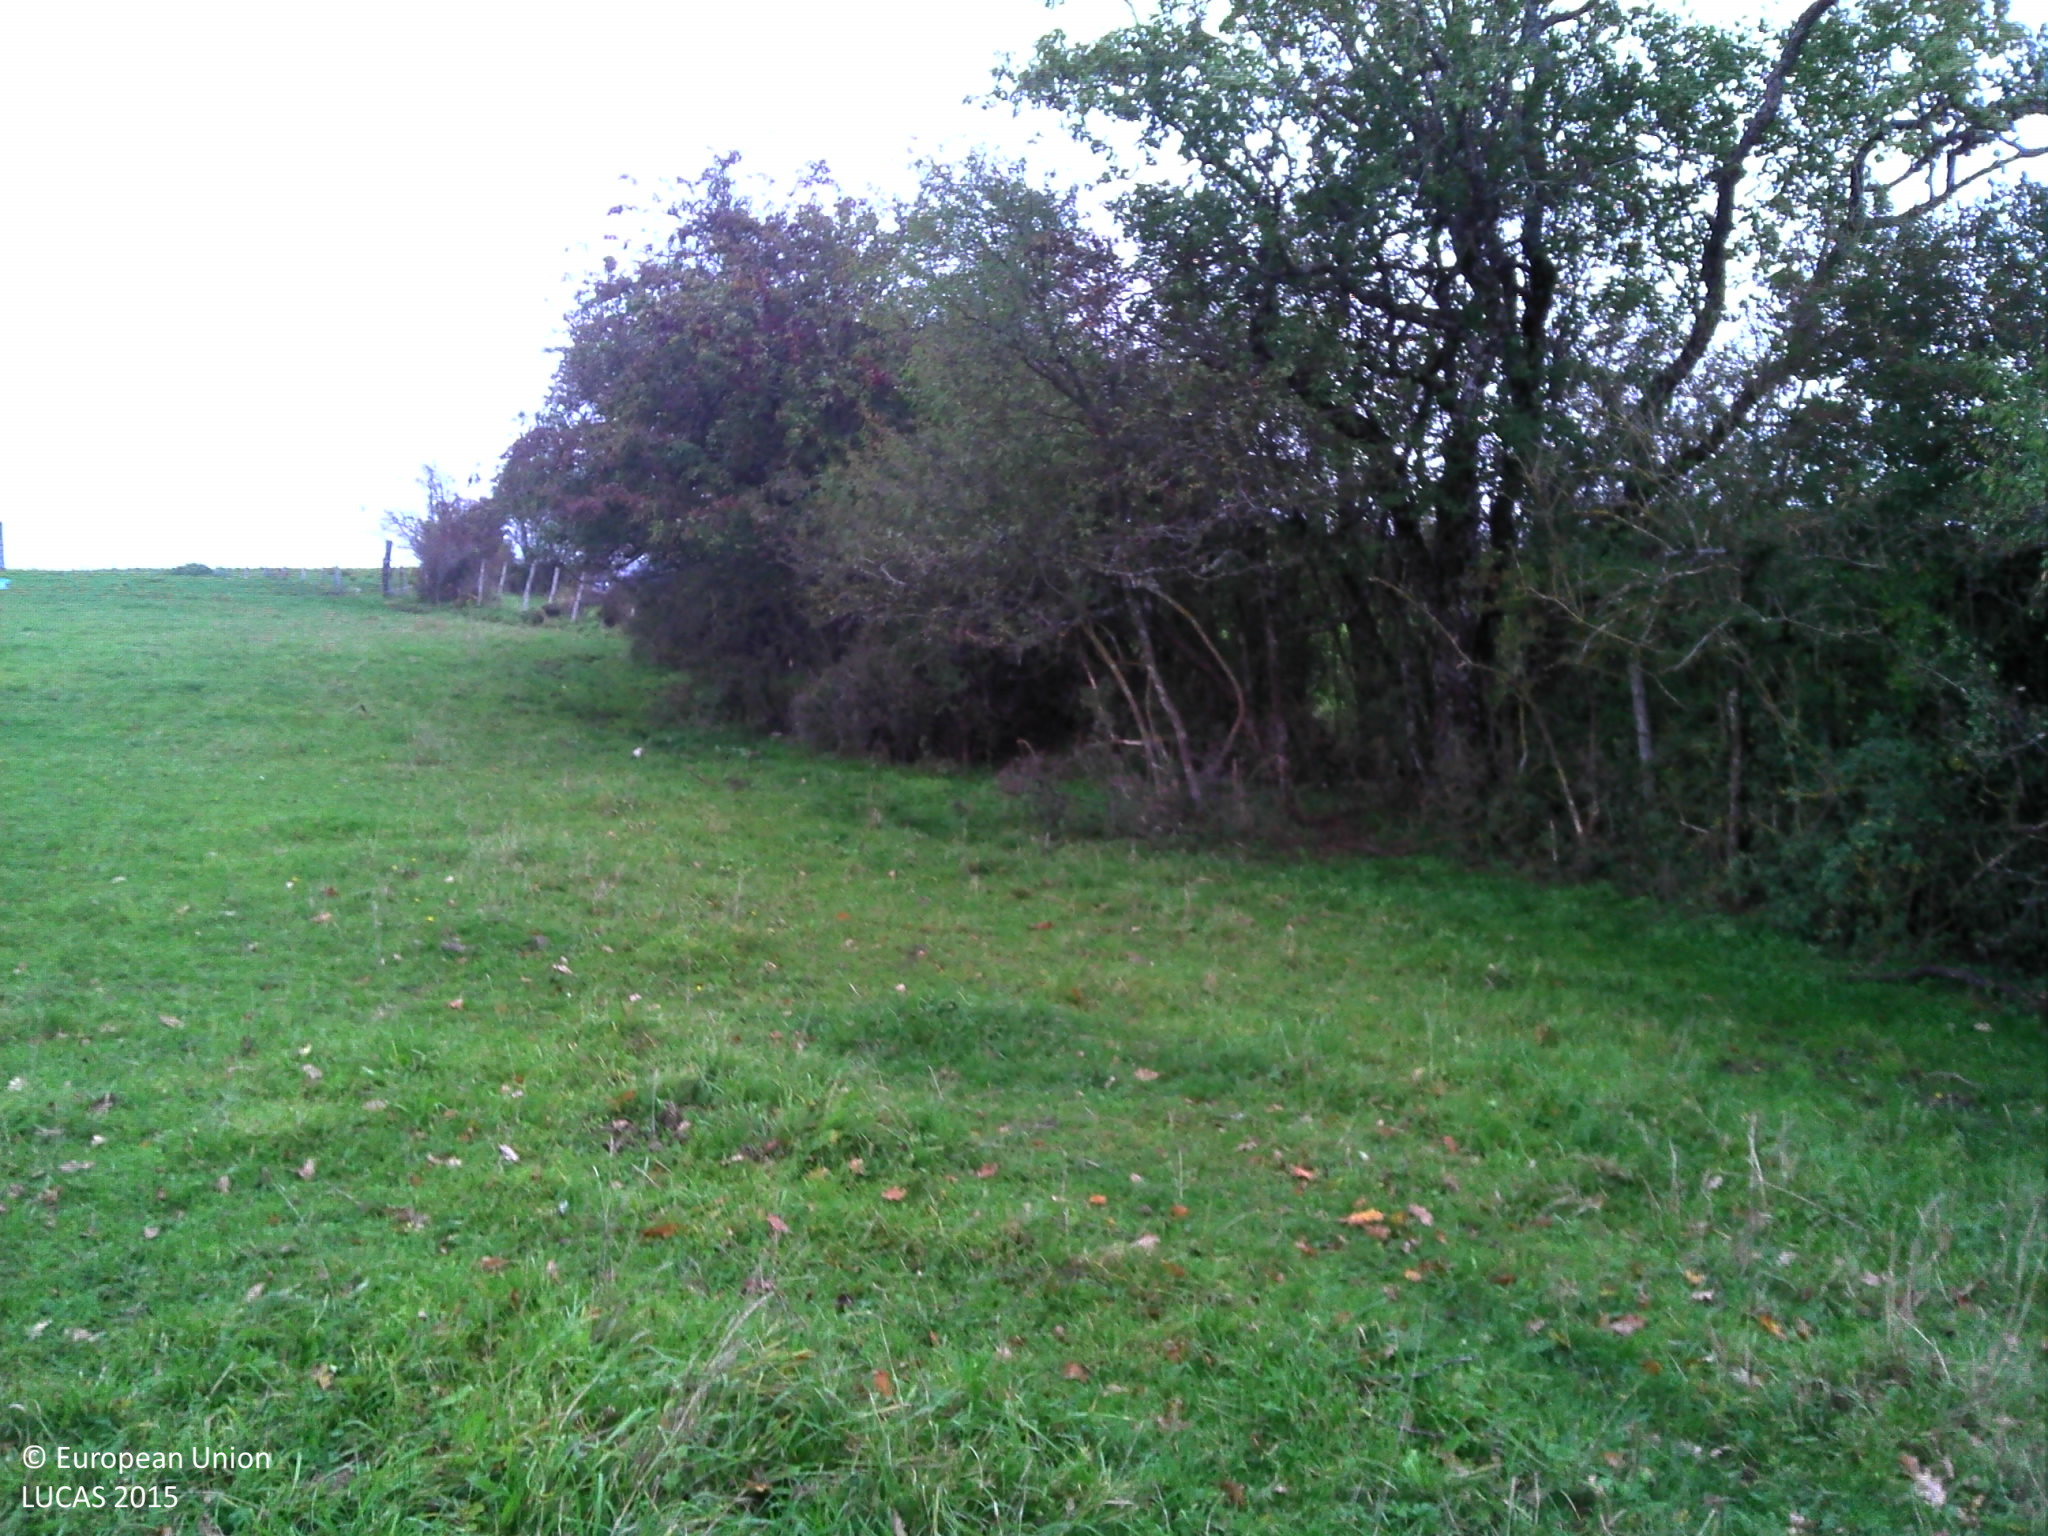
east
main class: Grassland
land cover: Grassland with sparse tree/shrub cover
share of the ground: > 75 %
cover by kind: herbaceous plants 95 %, broadleaved forest trees 5 %
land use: Agriculture (excluding fallow land and kitchen gardens)
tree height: > 5 m
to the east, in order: Grassland with sparse tree/shrub cover; Fences; Abandoned hedges; Grassland without tree/shrub cover; Fences; Tracks; Fences; Grassland without tree/shrub cover; Broadleaved woodland; Grassland without tree/shrub cover
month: October
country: FR
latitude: 46.9887
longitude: 6.2550
